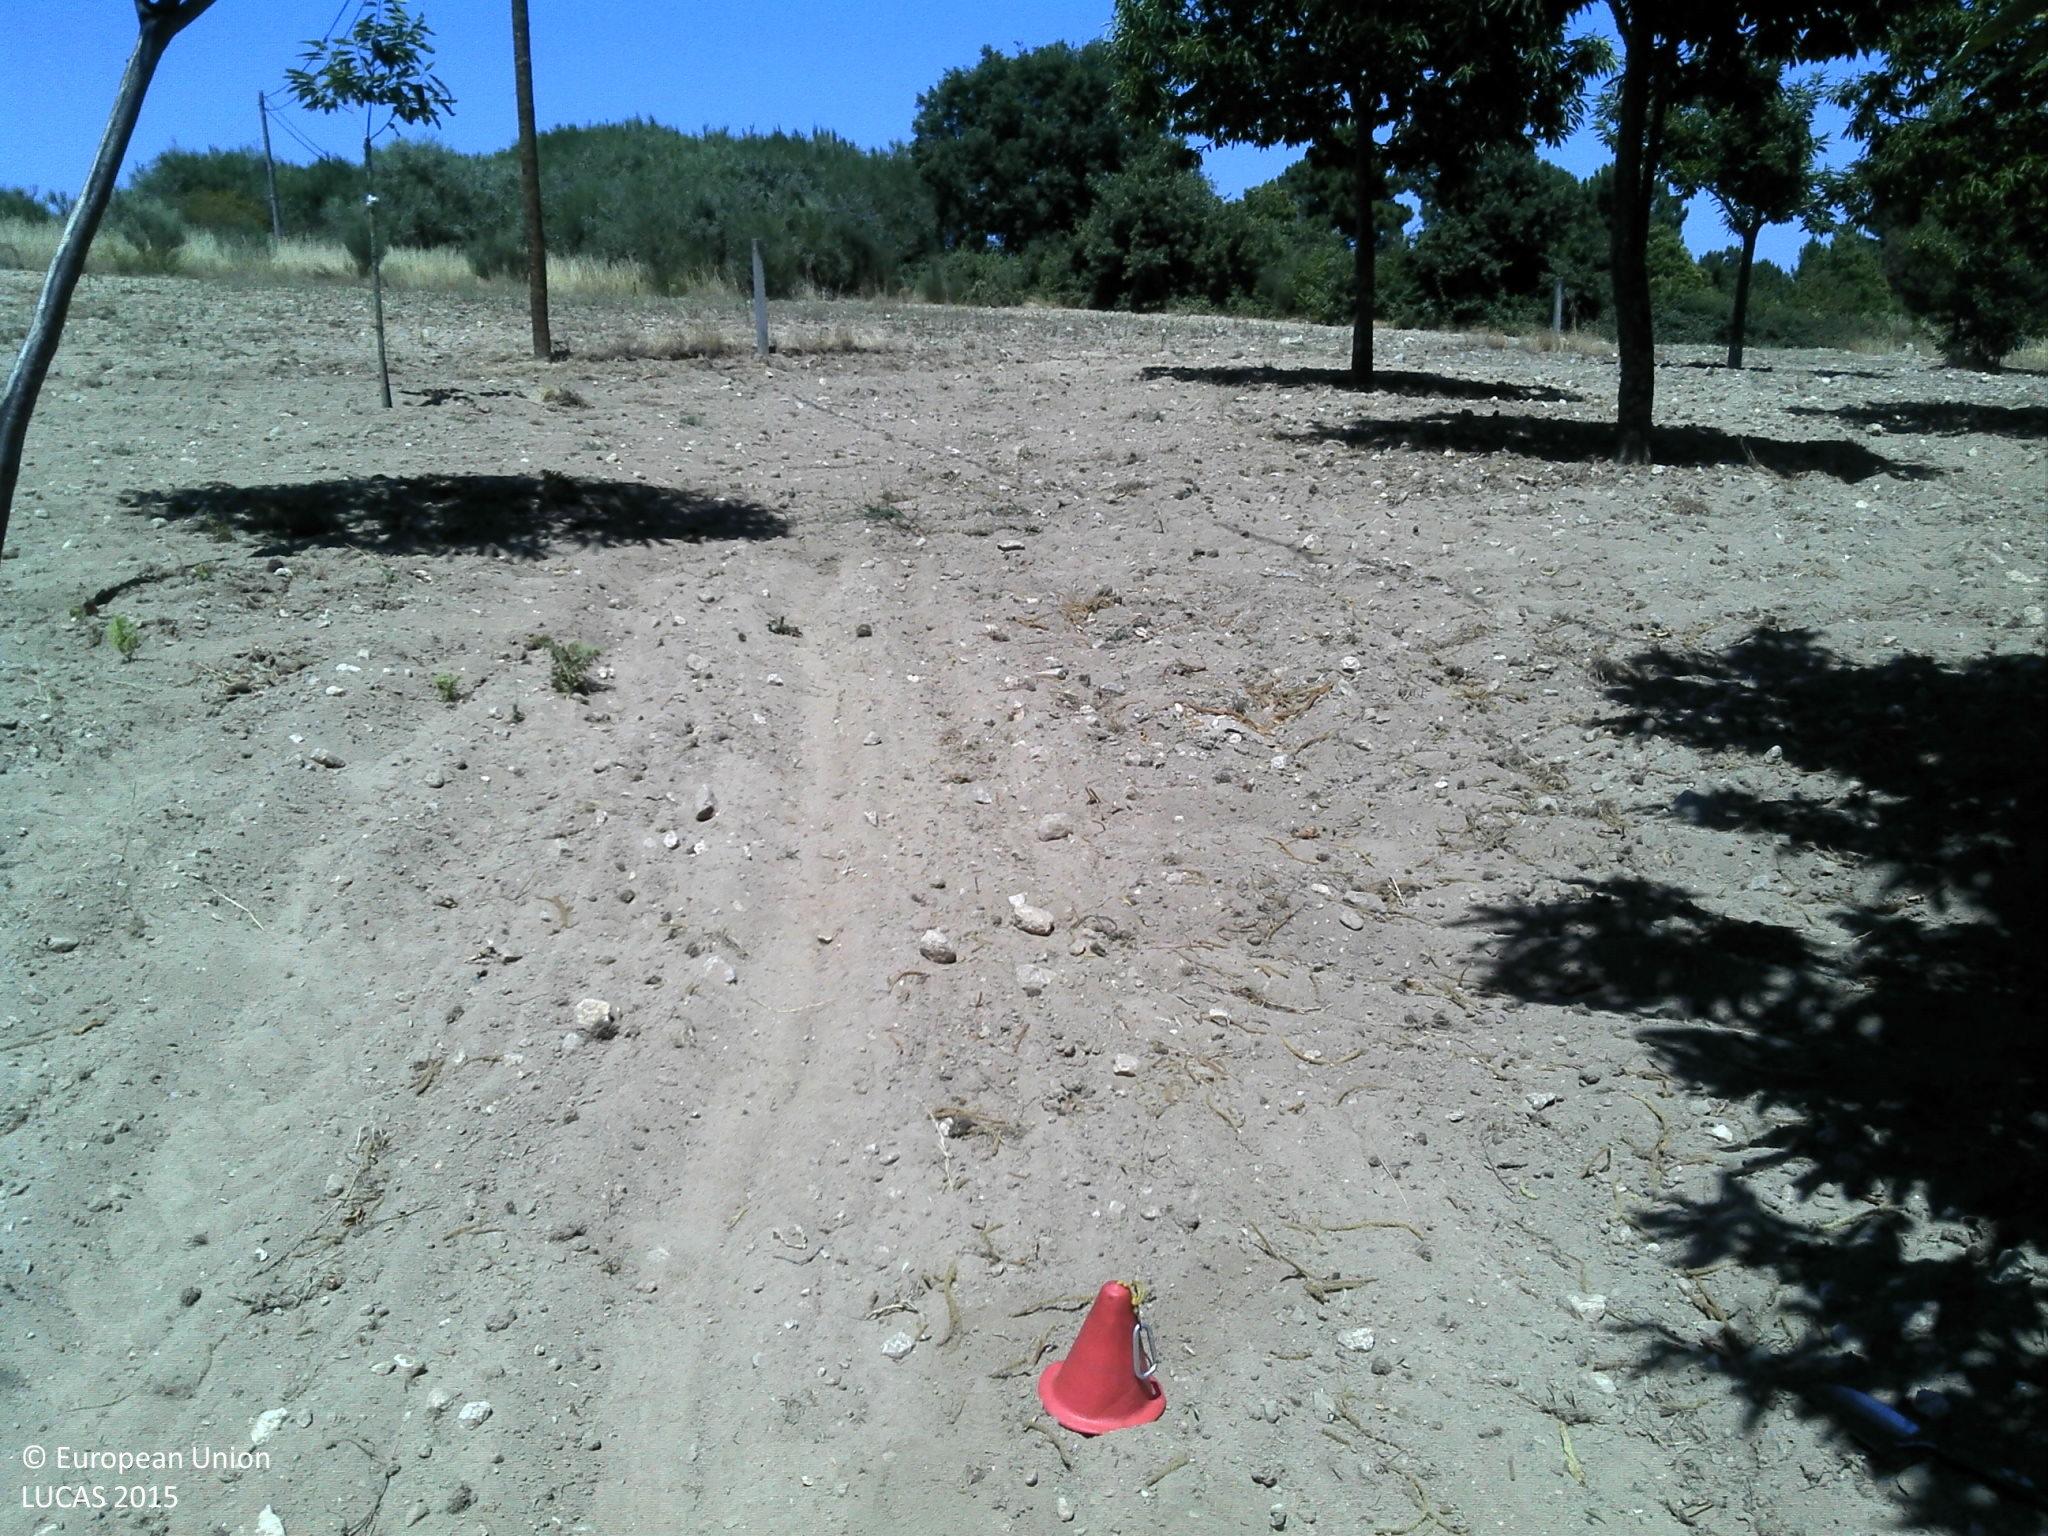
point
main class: Cropland
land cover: Nuts trees
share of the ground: 25 - 50 %
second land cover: Other bare soil
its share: > 75 %
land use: Agriculture (excluding fallow land and kitchen gardens)
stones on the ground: 10 - 25 %
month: July
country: PT
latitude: 41.7213
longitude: -7.6237
